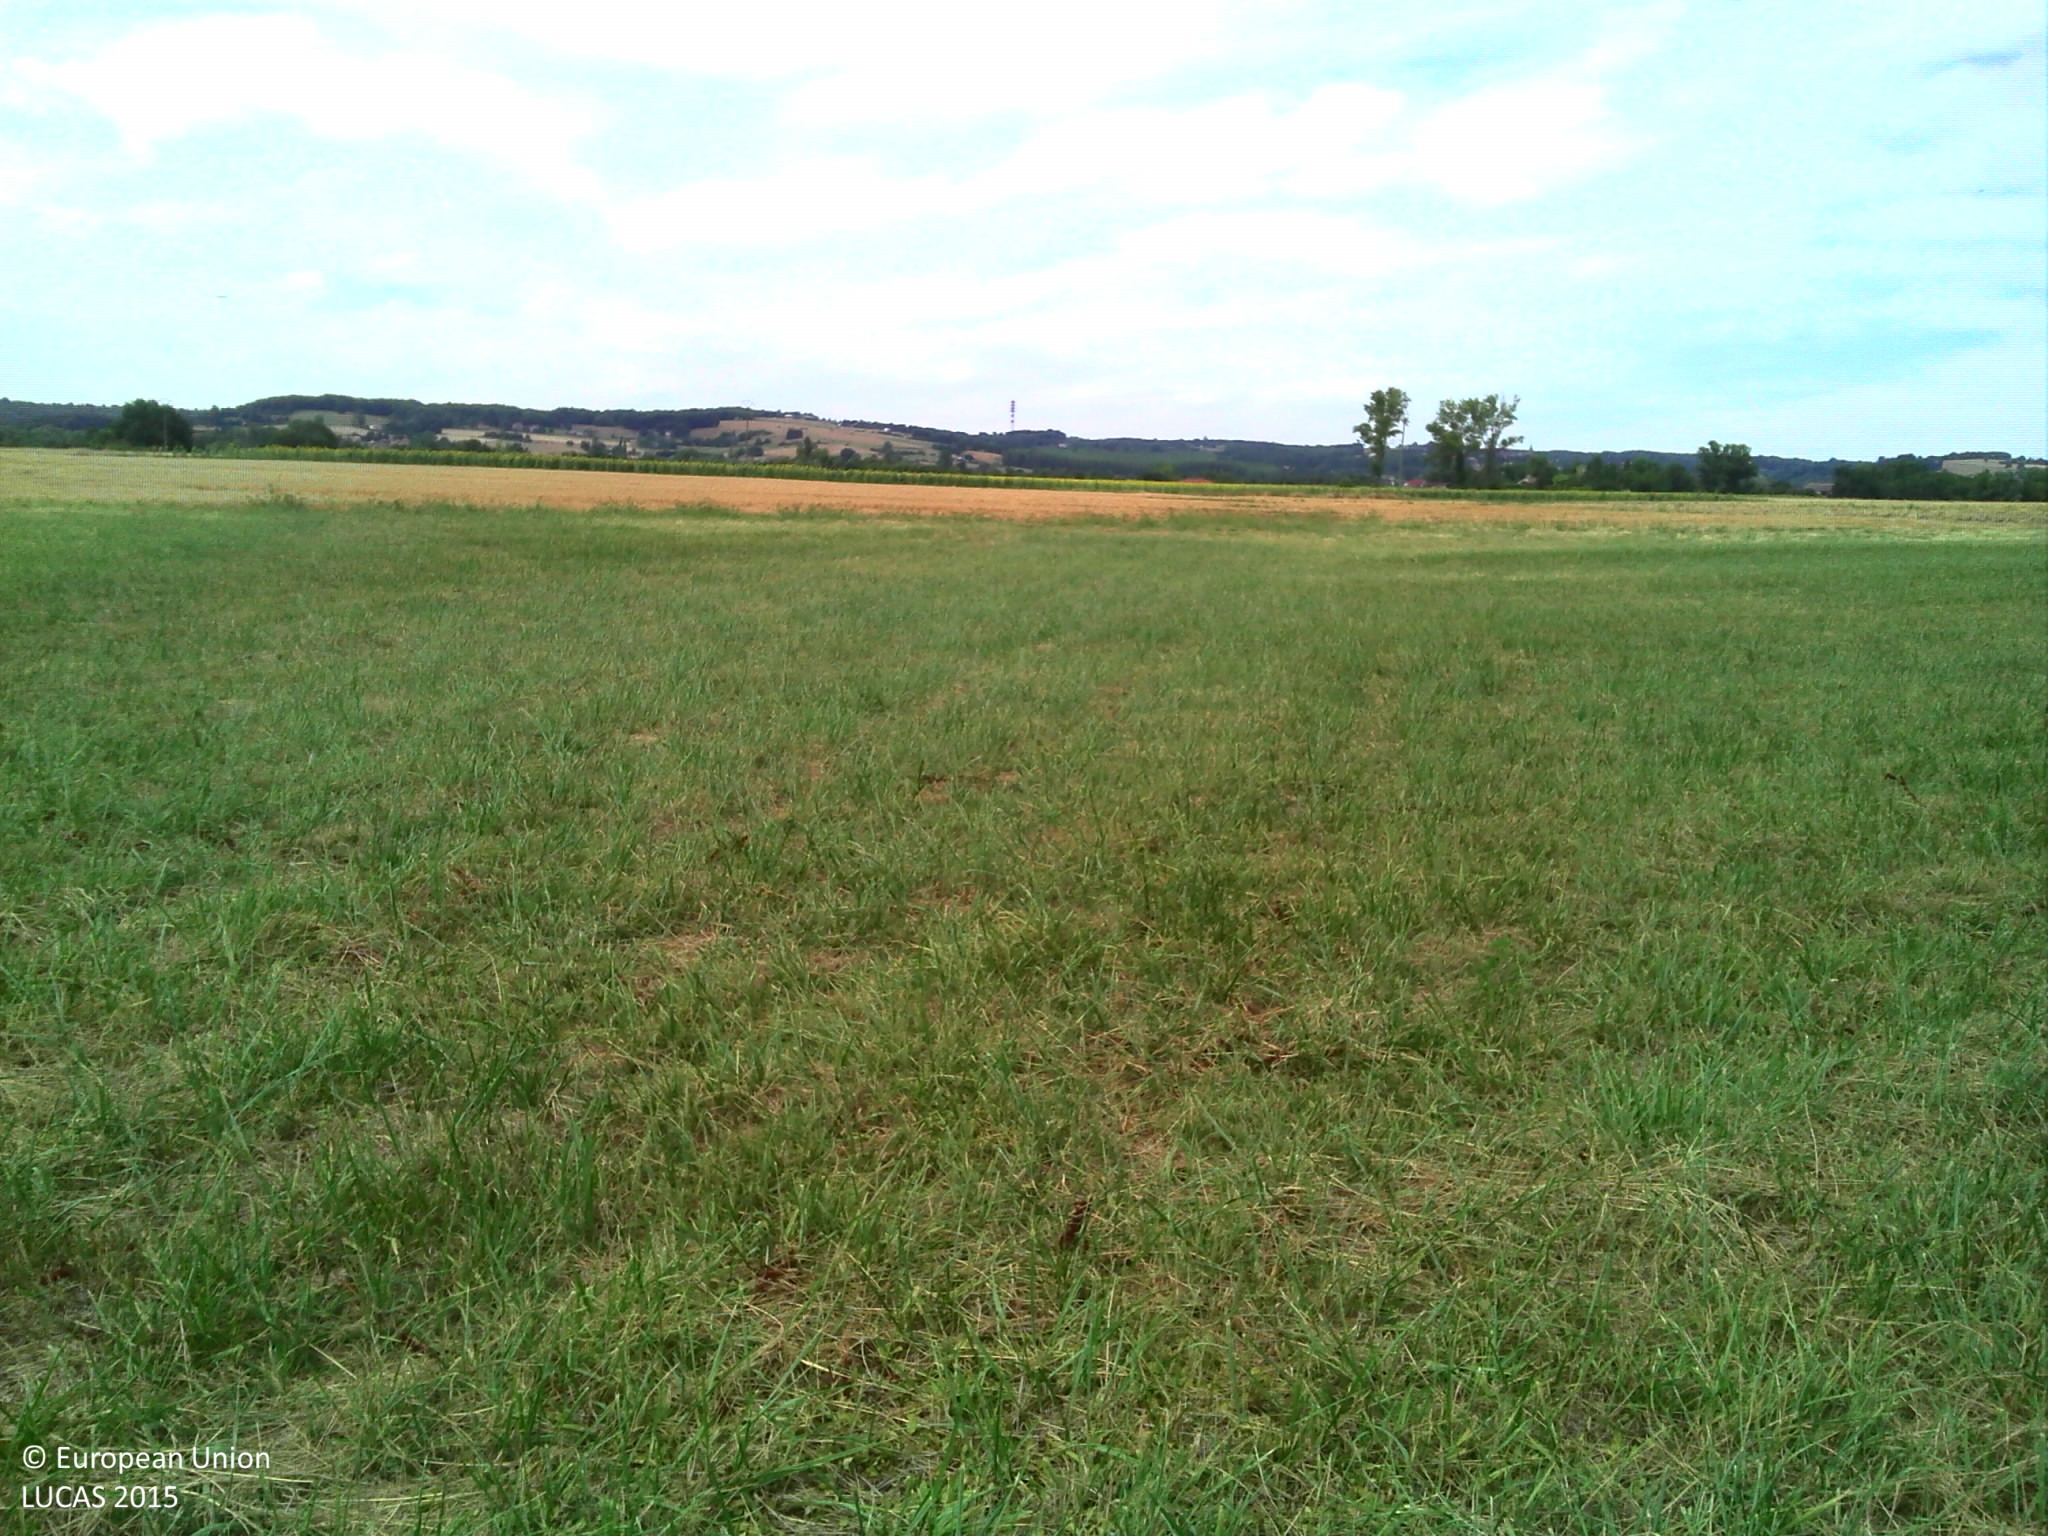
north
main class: Cropland
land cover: Temporary grasslands
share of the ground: > 75 %
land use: Agriculture (excluding fallow land and kitchen gardens)
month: July
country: FR
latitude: 45.3685
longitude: 5.0124
